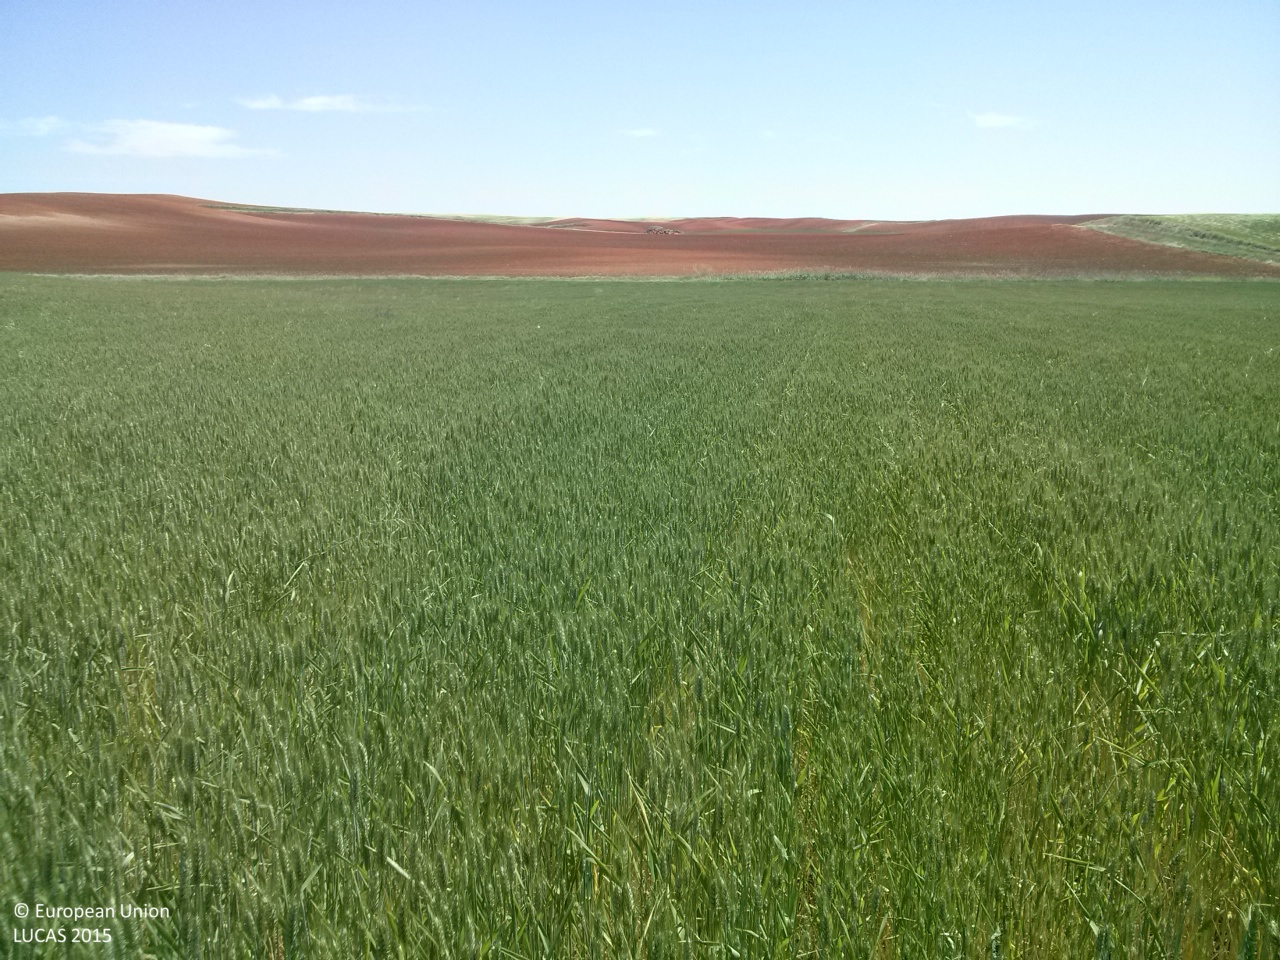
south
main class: Cropland
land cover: Common wheat
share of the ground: > 75 %
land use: Agriculture (excluding fallow land and kitchen gardens)
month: May
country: ES
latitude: 40.1410
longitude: -2.7816
